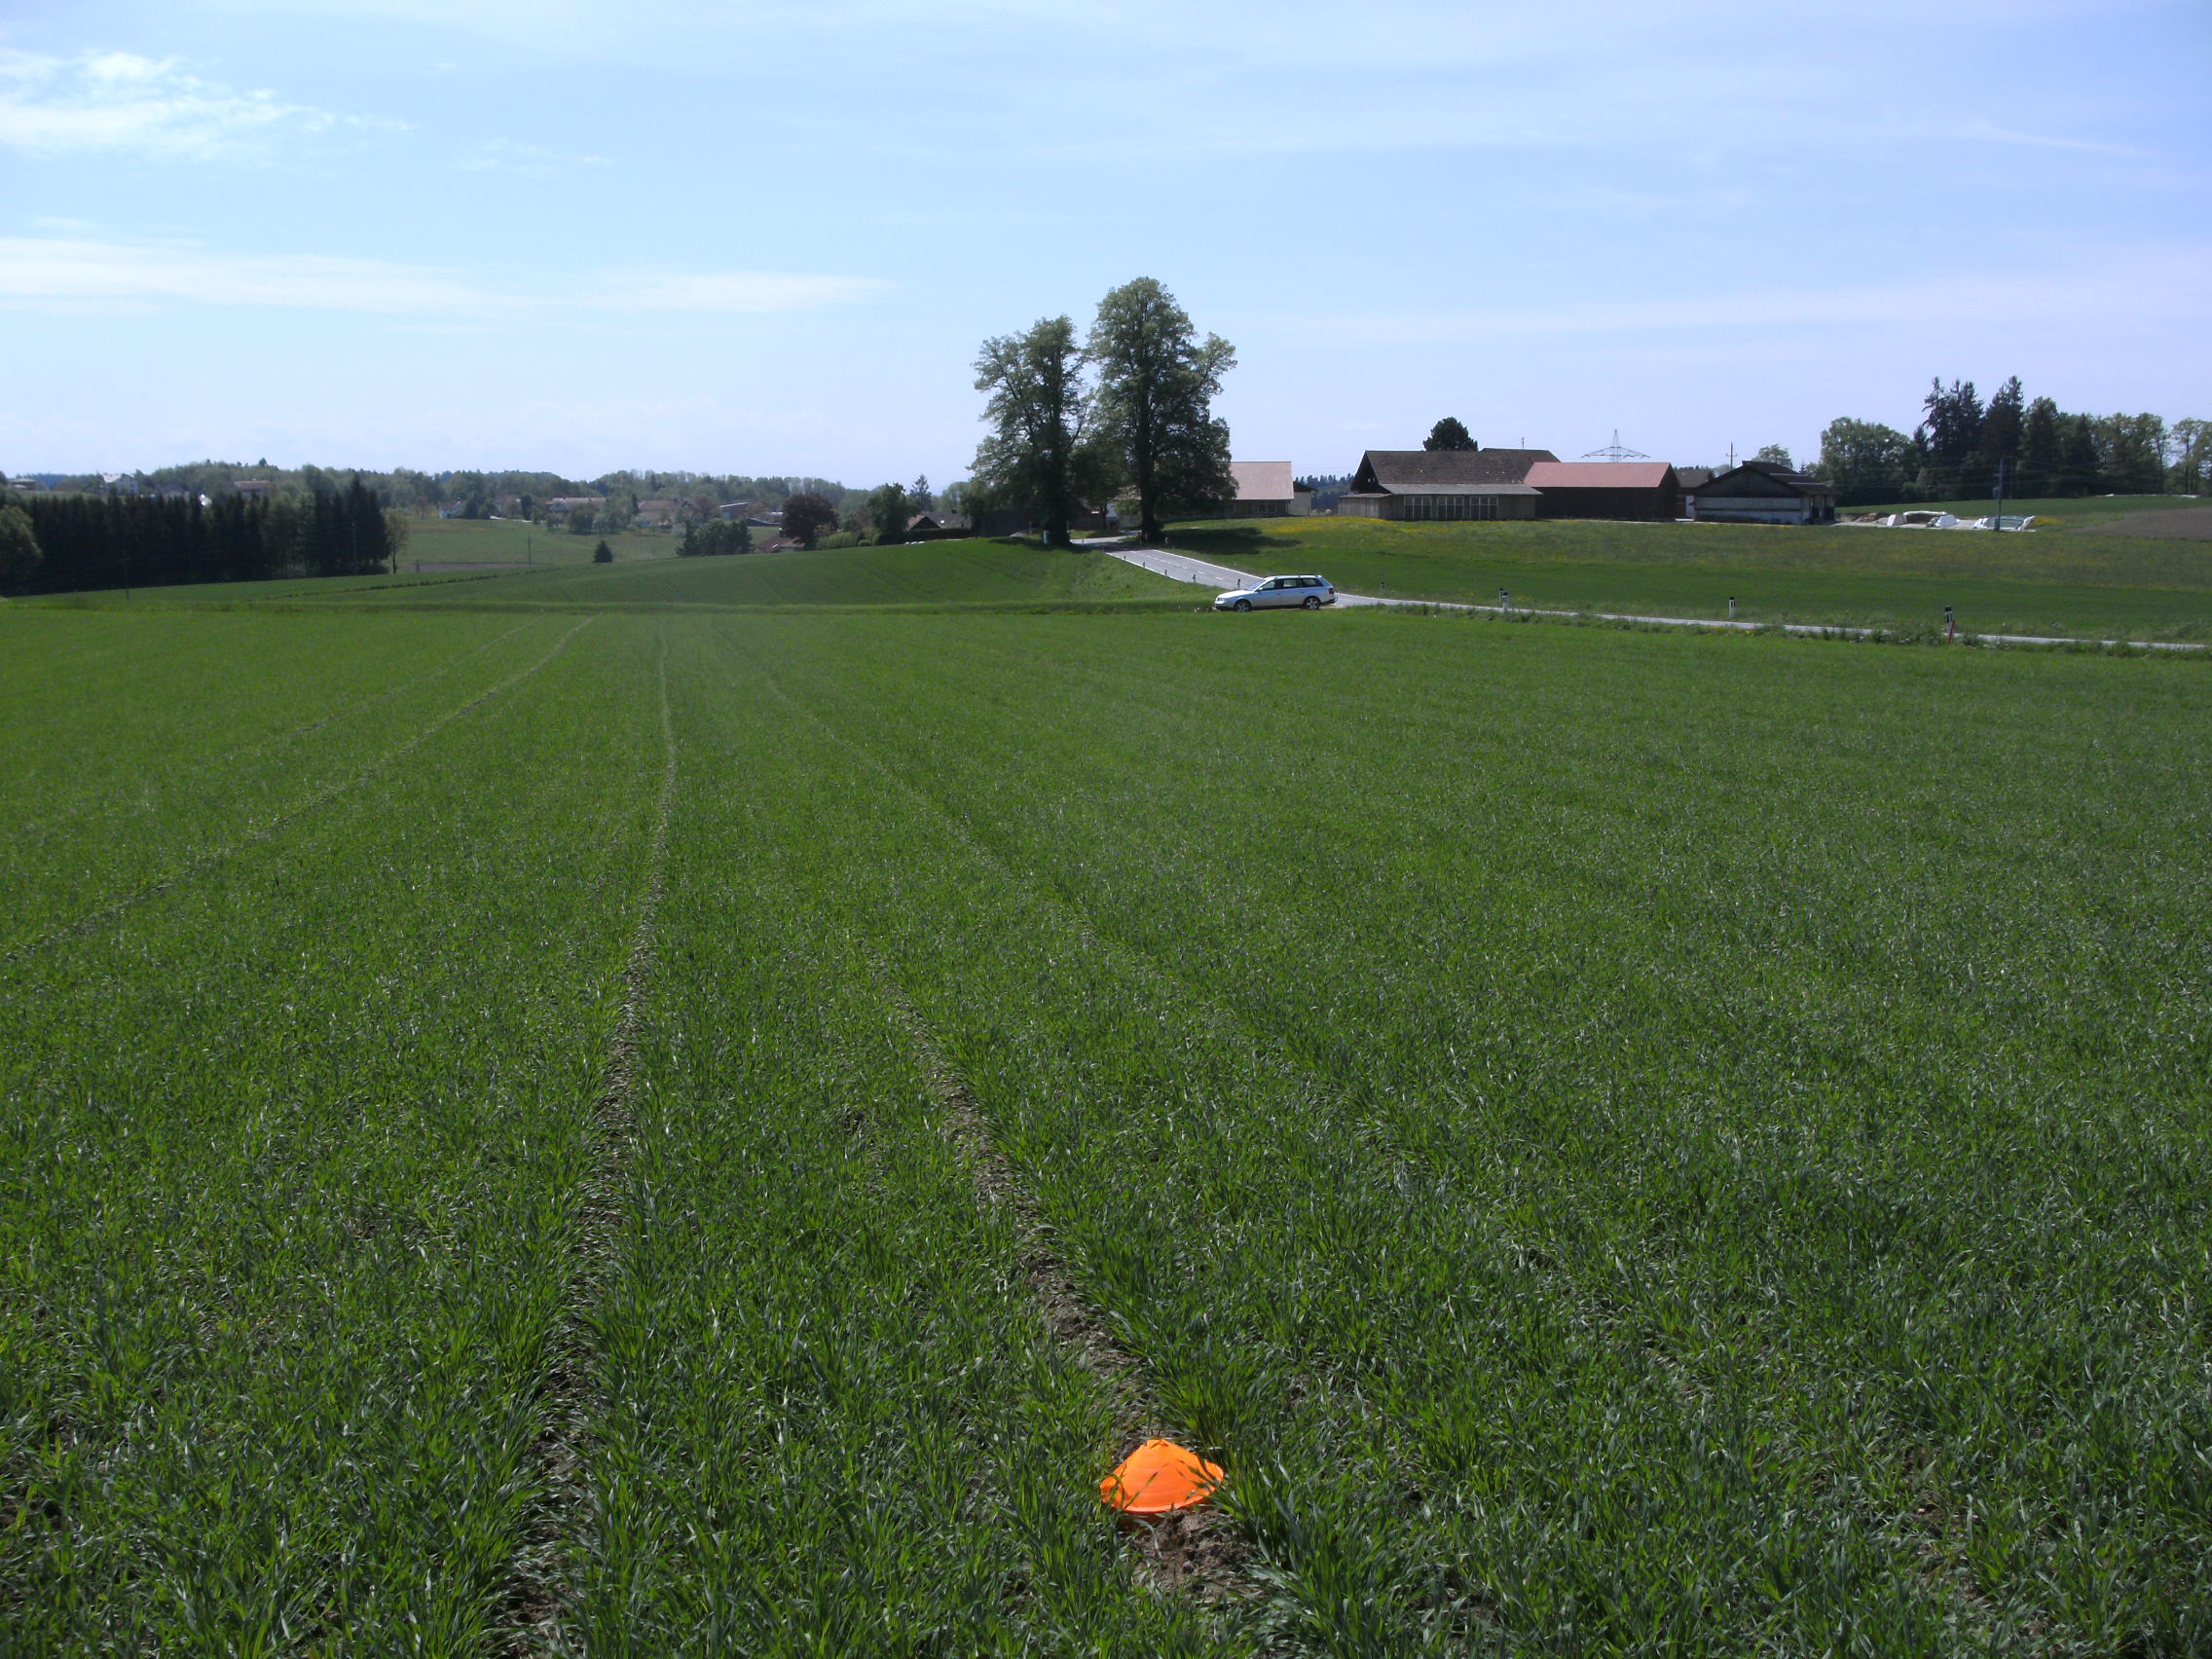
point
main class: Cropland
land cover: Barley
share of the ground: > 75 %
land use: Agriculture (excluding fallow land and kitchen gardens)
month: May
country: AT
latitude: 48.5109
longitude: 13.4785
